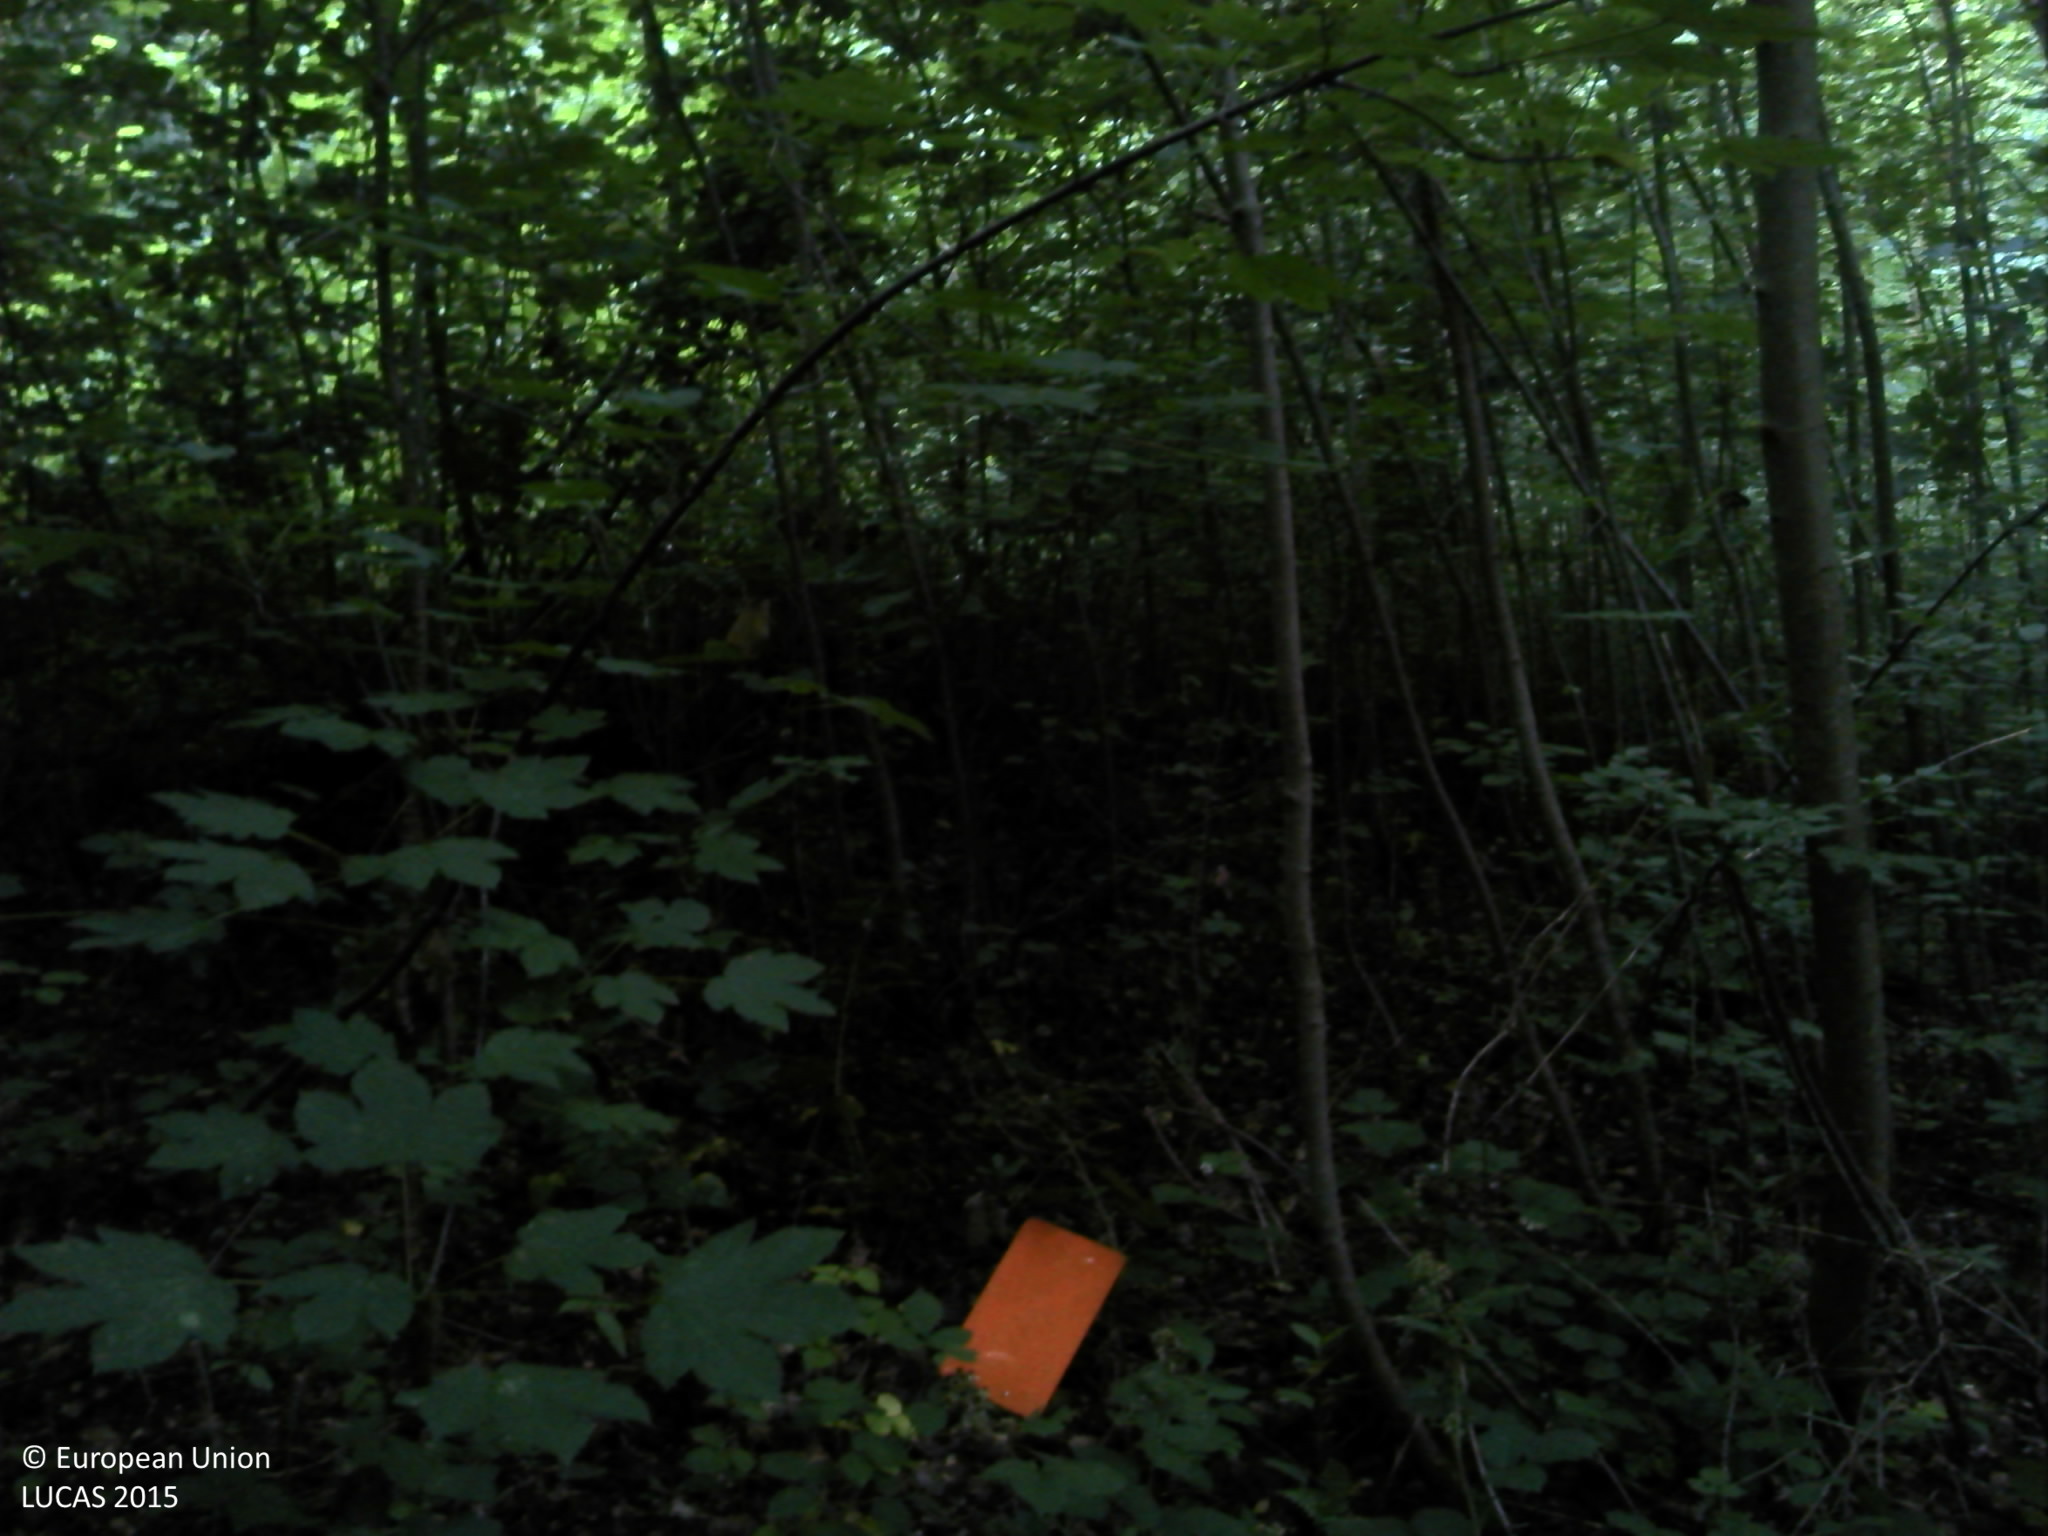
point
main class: Woodland
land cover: Broadleaved woodland
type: beech forest
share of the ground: > 75 %
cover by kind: broadleaved forest trees 80 %, consolidated bare surface 15 %, herbaceous plants 5 %
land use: Forestry
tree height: > 5 m
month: July
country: FR
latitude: 49.6728
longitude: 4.4949
